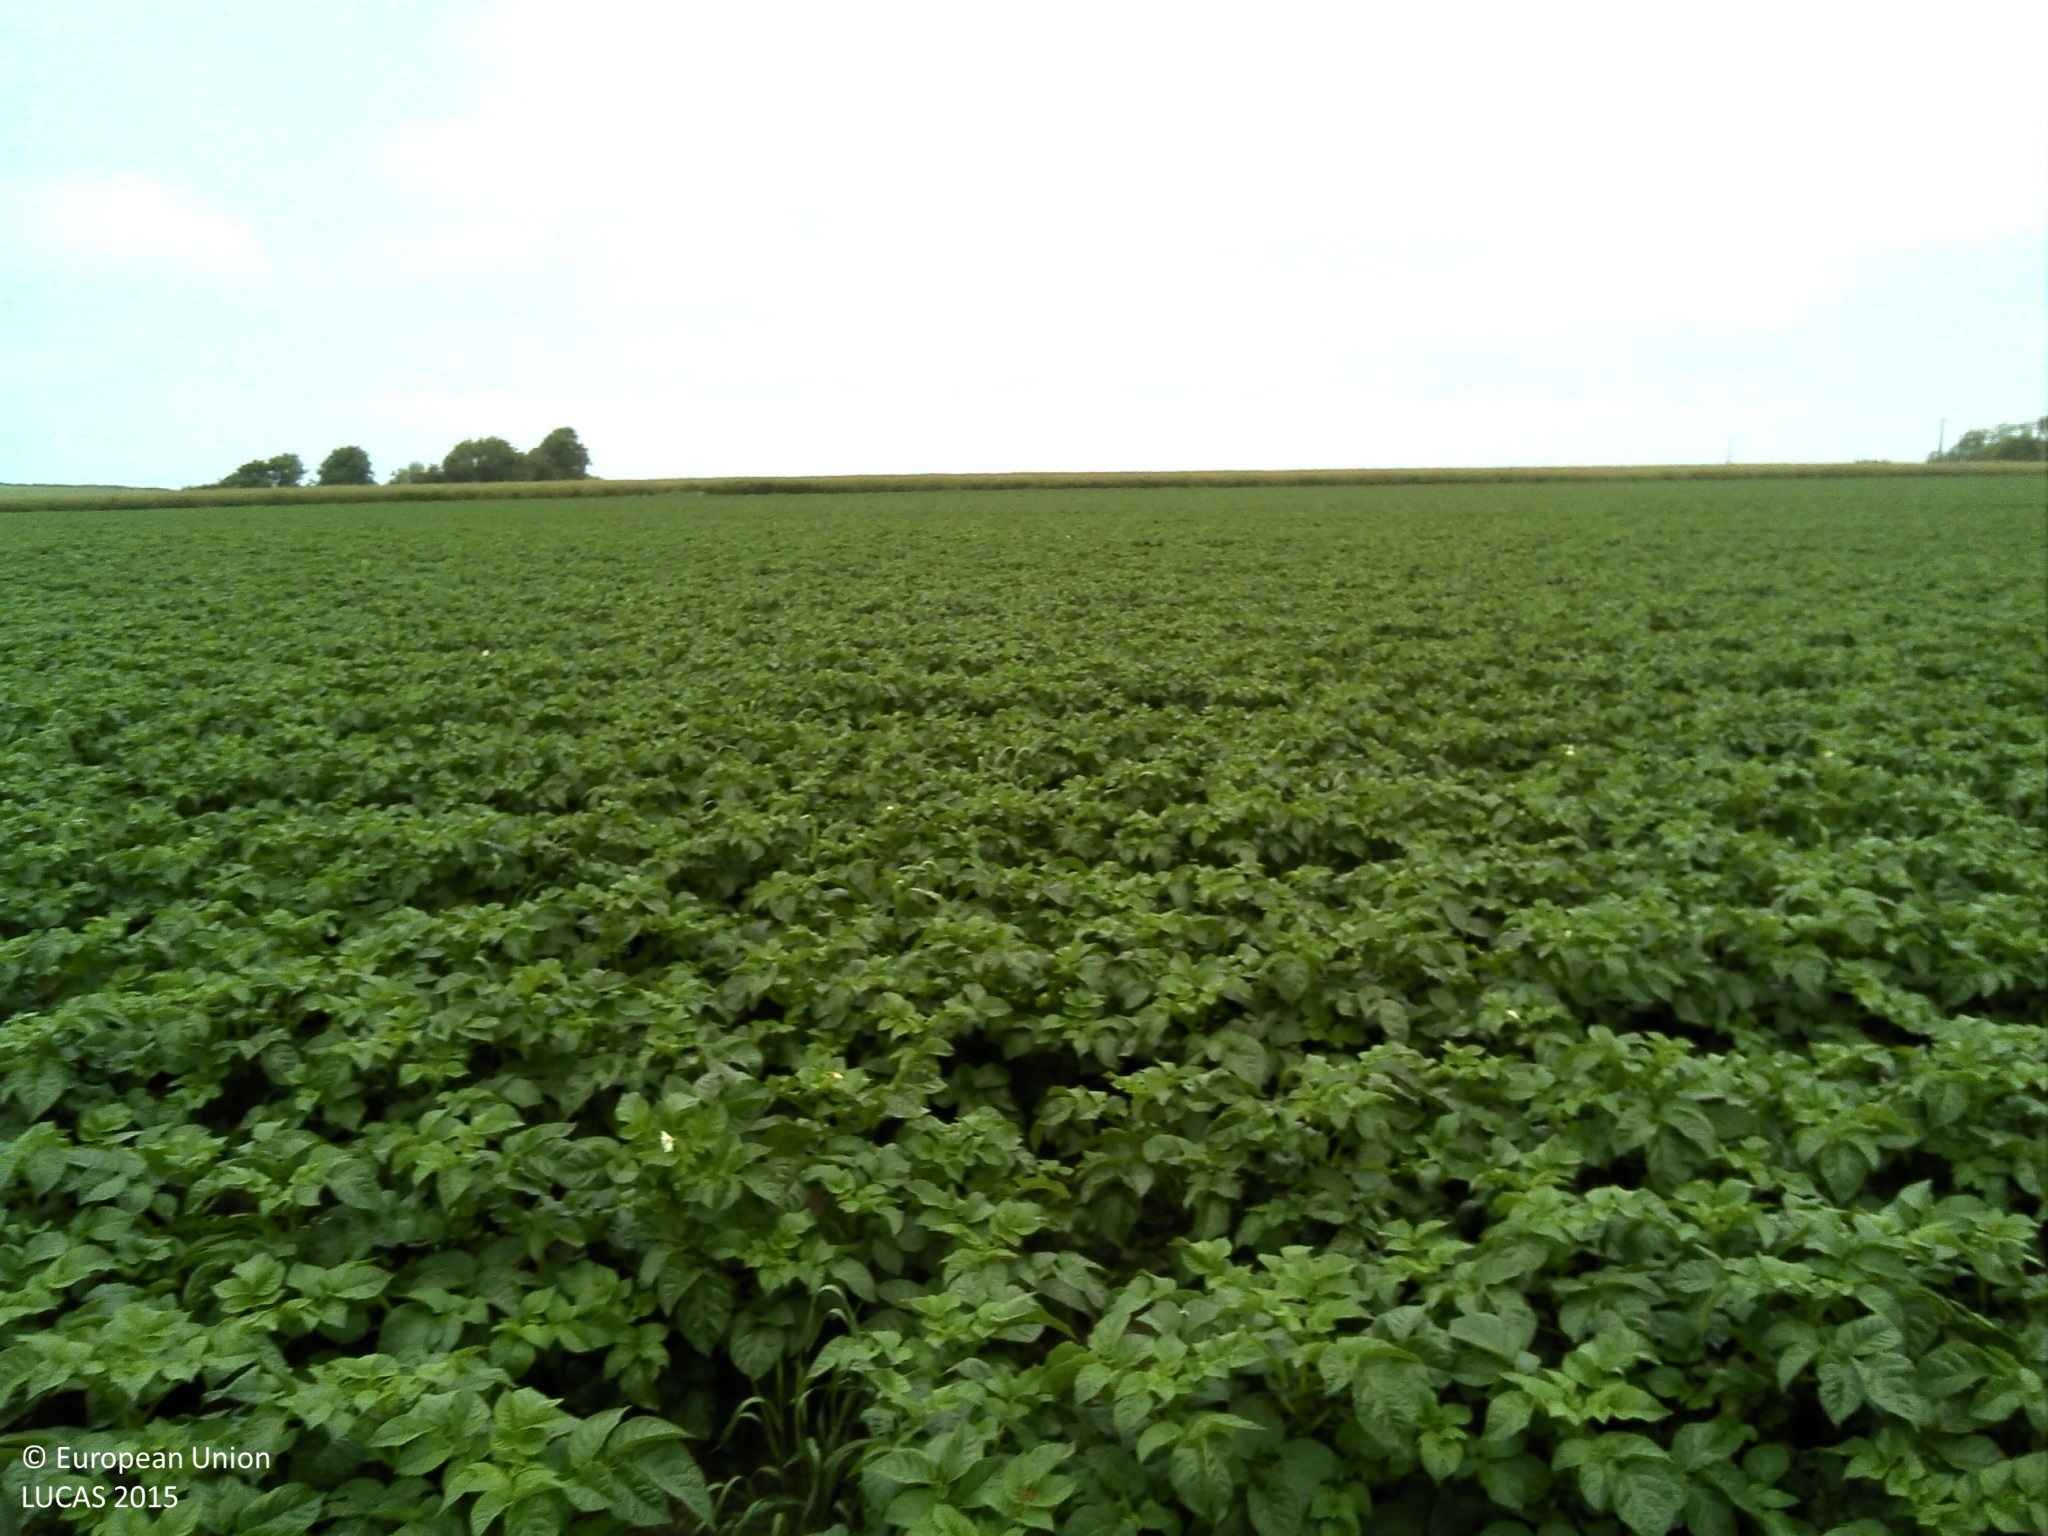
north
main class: Cropland
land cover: Potatoes
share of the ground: > 75 %
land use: Agriculture (excluding fallow land and kitchen gardens)
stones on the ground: < 10 %
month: June
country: FR
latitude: 49.7336
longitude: 0.3007
